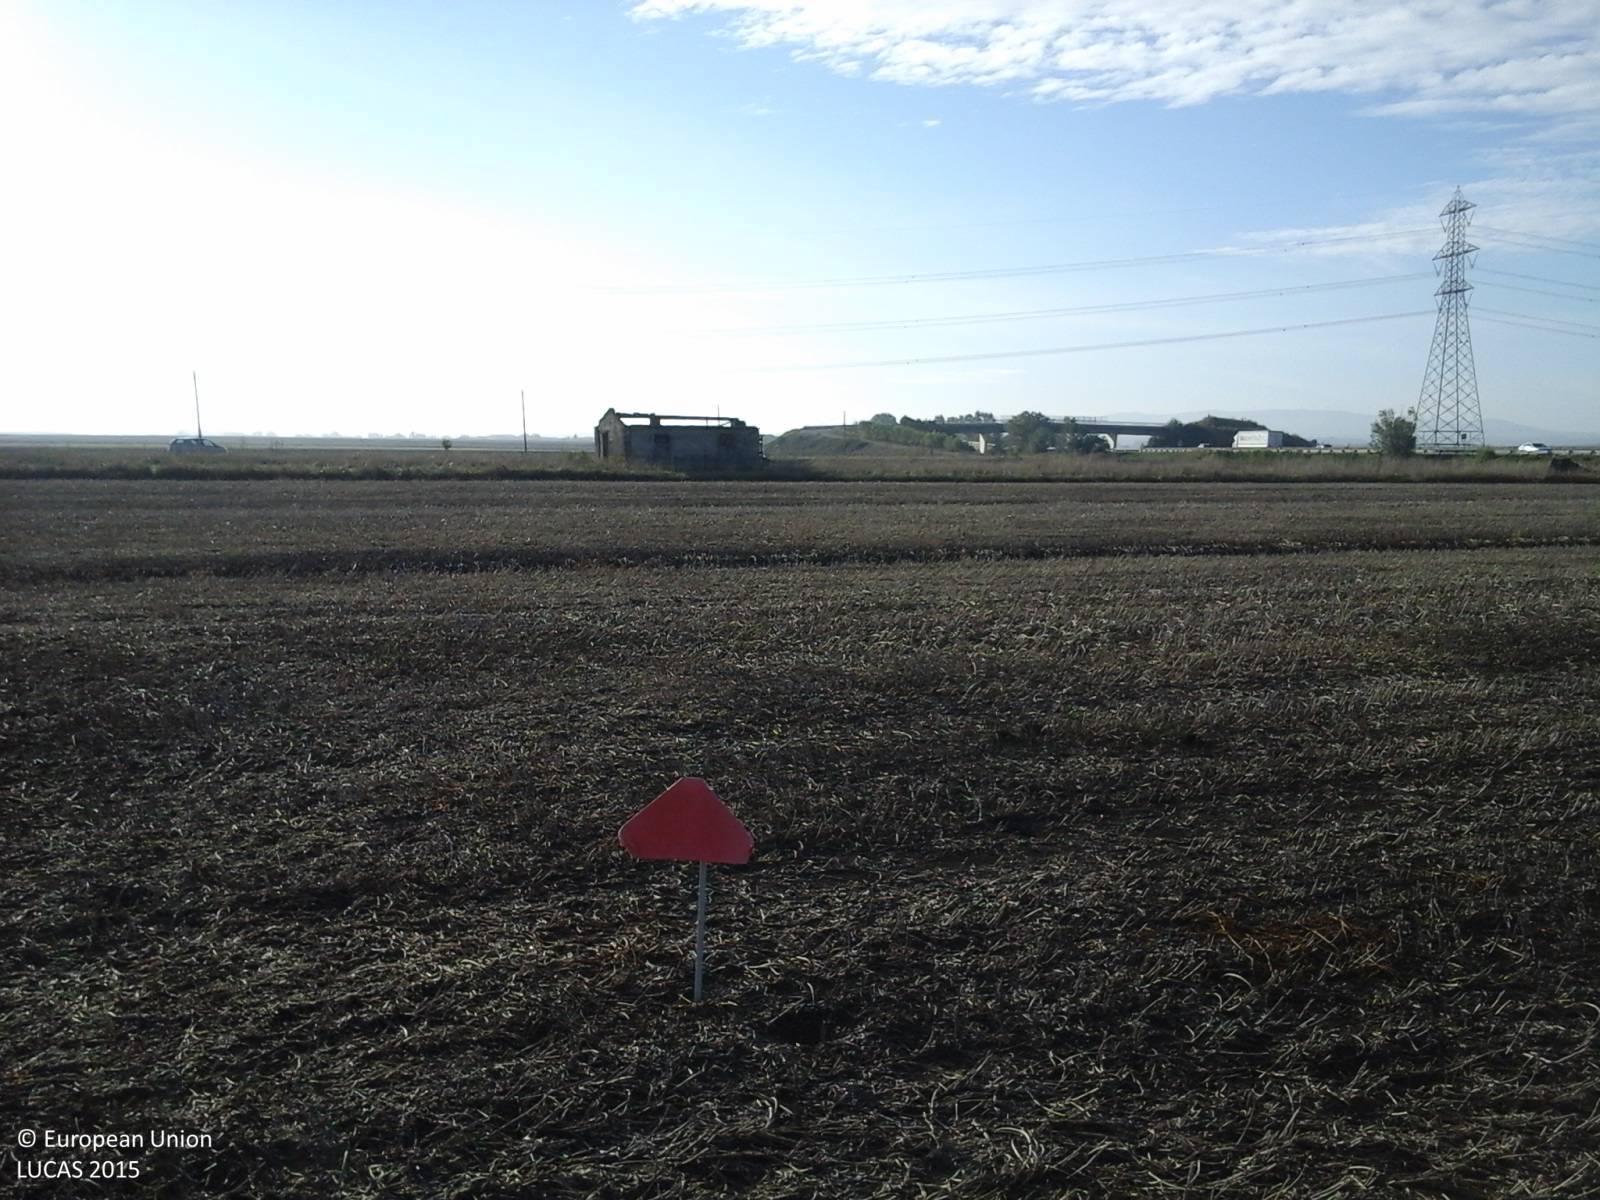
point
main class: Cropland
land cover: Mixed cereals for fodder
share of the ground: 50 - 75 %
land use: Agriculture (excluding fallow land and kitchen gardens)
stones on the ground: < 10 %
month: October
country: IT
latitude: 43.6454
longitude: 10.5564
